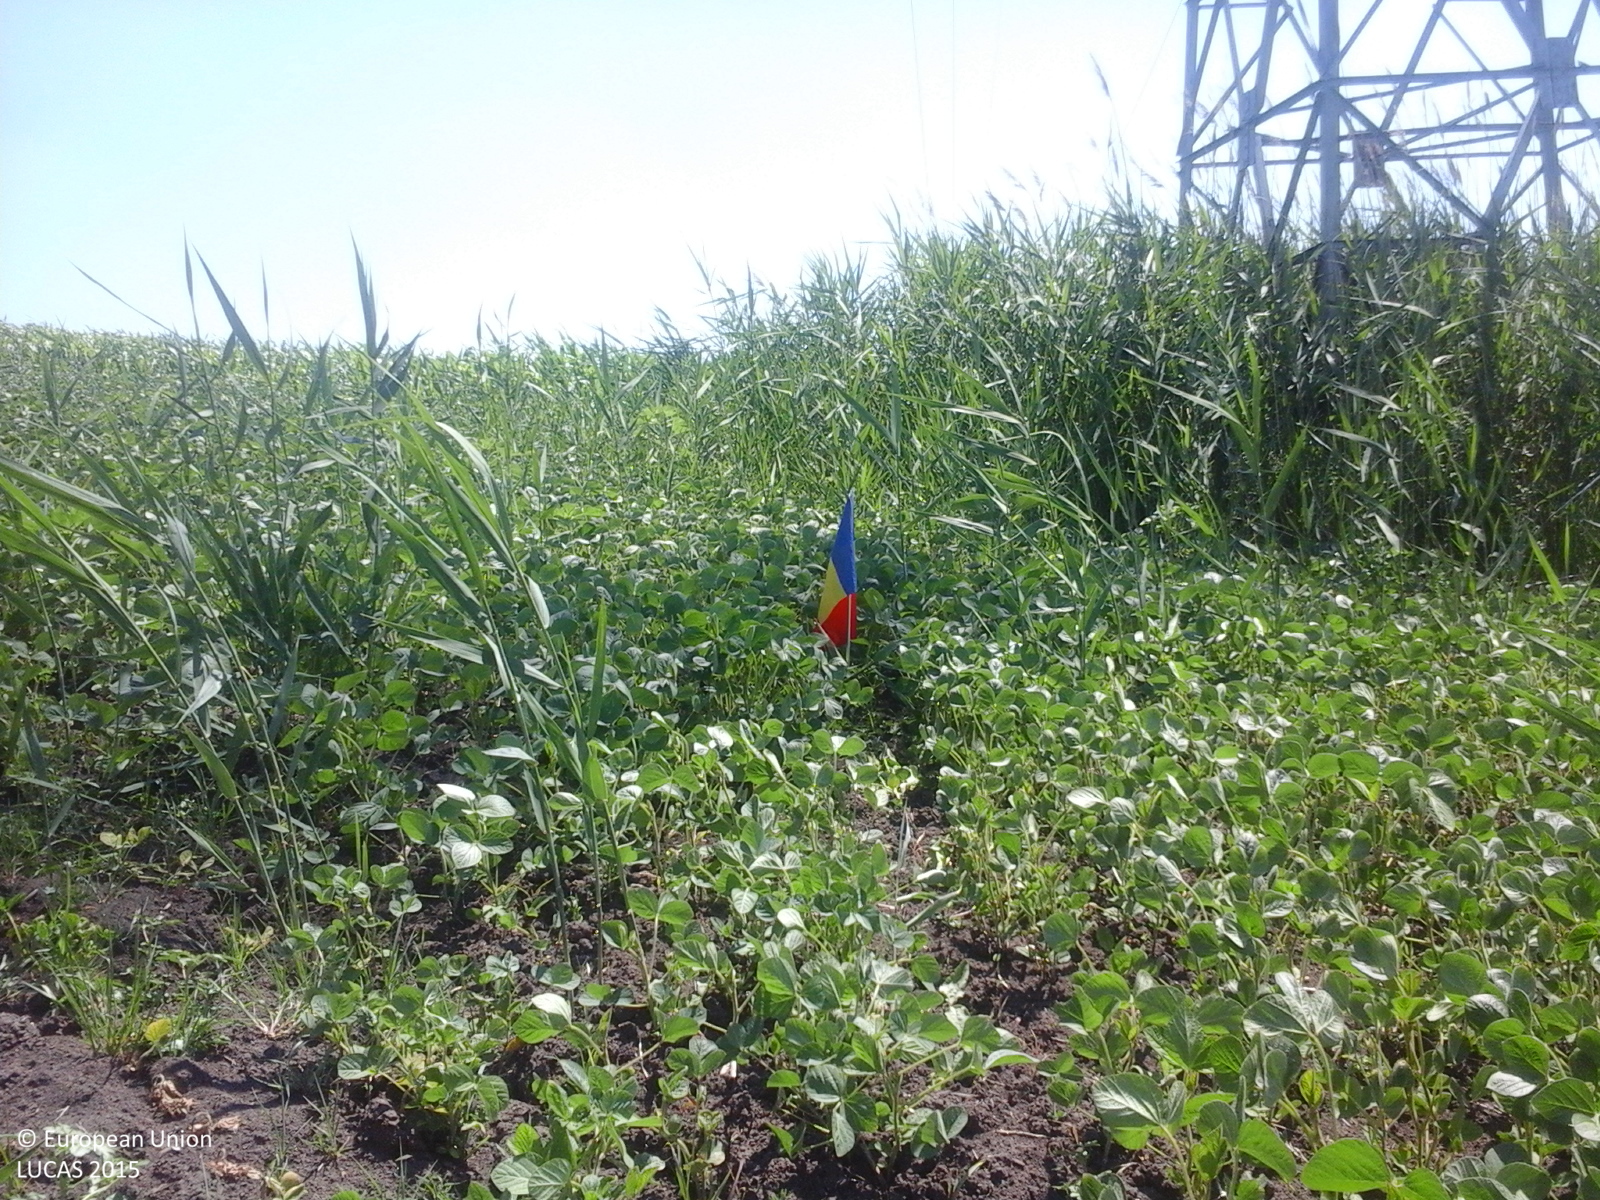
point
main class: Cropland
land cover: Soya
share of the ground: > 75 %
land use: Agriculture (excluding fallow land and kitchen gardens)
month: June
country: RO
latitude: 47.7841
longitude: 27.0439
